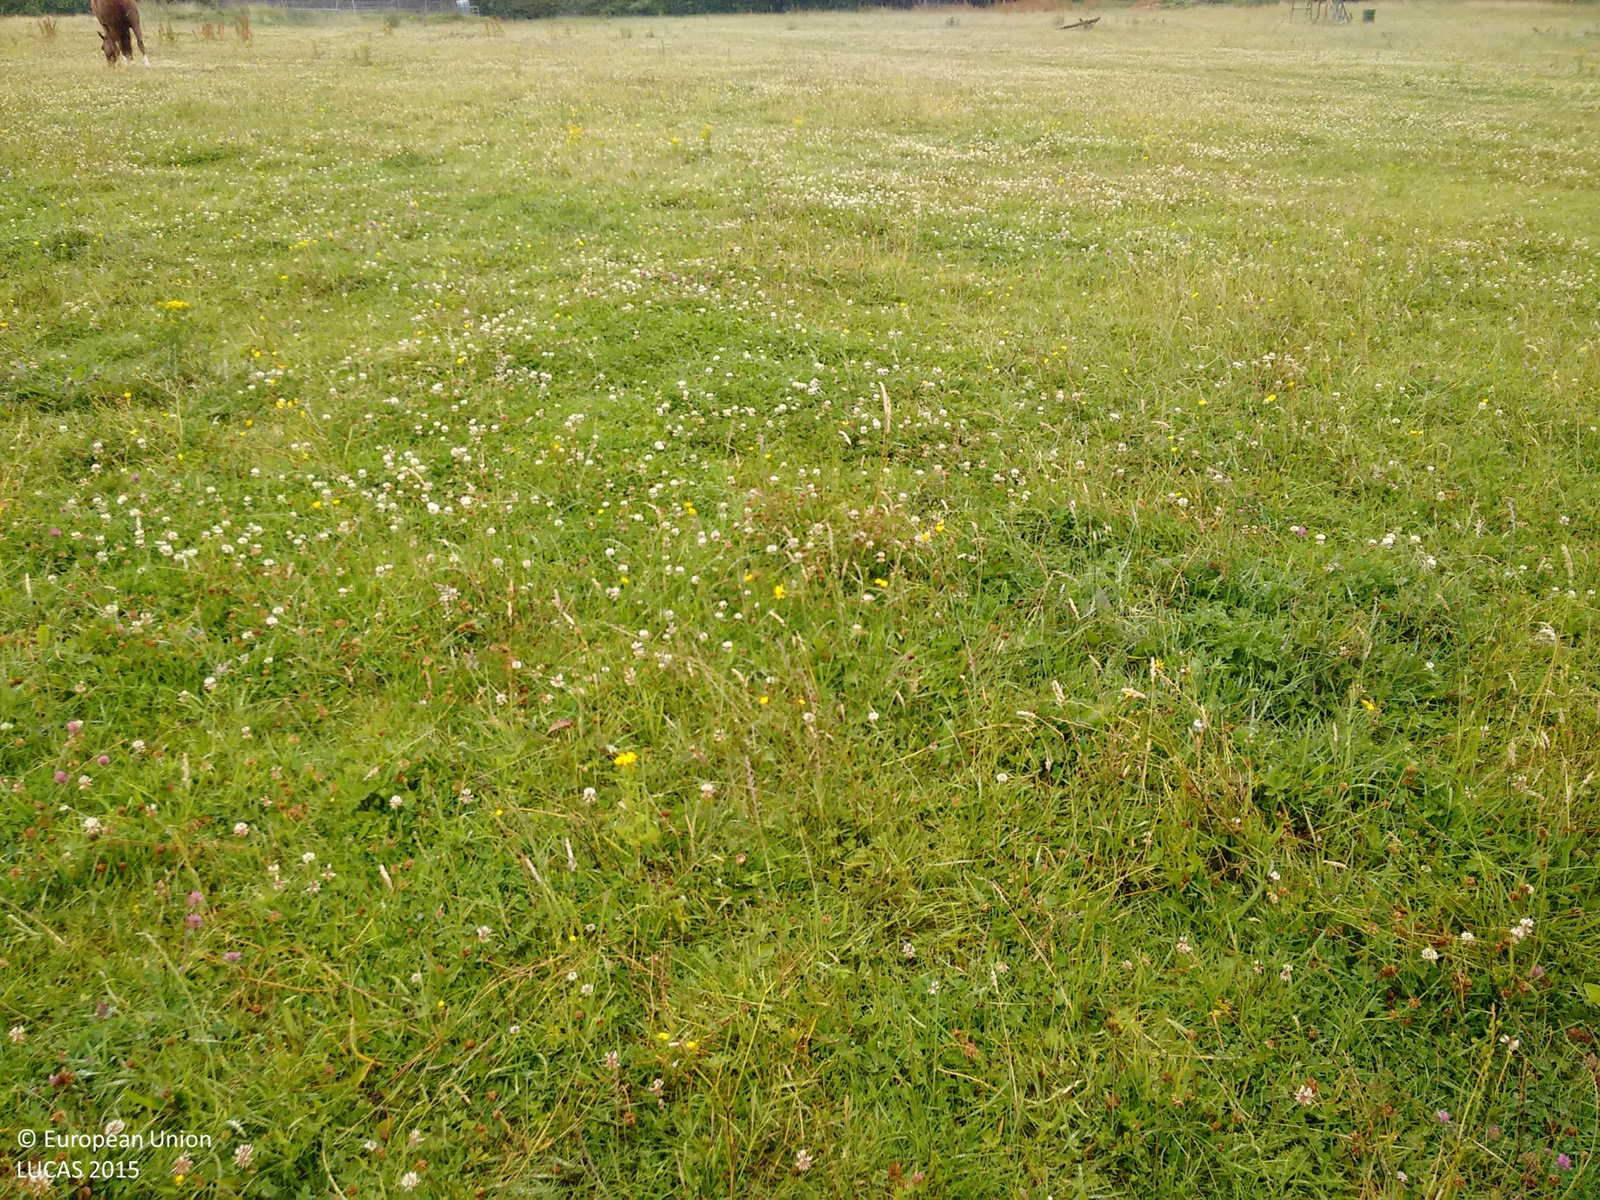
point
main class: Grassland
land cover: Grassland without tree/shrub cover
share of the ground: > 75 %
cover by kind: herbaceous plants 100 %
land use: Agriculture (excluding fallow land and kitchen gardens)
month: July
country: GB
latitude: 53.0665
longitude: -1.3455
